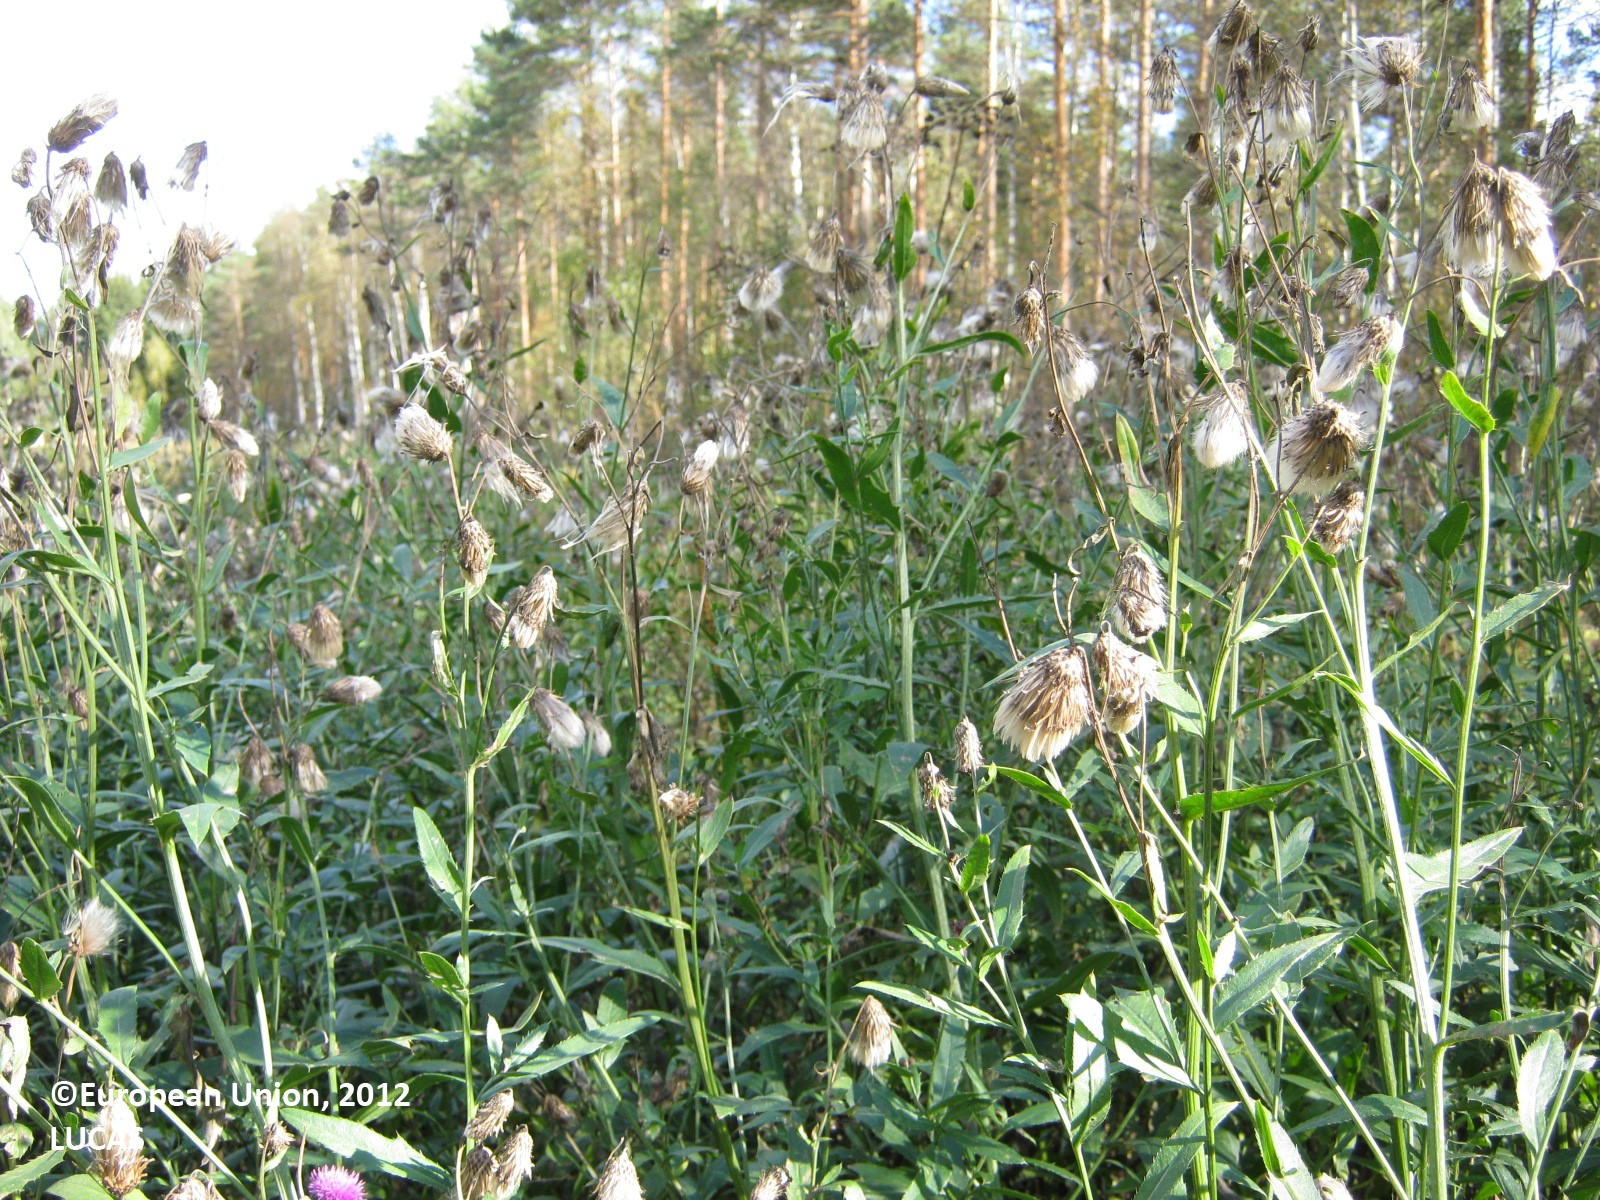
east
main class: Shrubland
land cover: Shrubland with sparse tree cover
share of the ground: > 75 %
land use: Semi-natural and natural areas not in use
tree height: < 5 m
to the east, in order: Shrubland with sparse tree cover; Ditches and canals; Spruce dominated mixed woodland; Other mixed woodland; Ditches and canals; Other coniferous woodland; Broadleaved woodland; Ditches and canals; Paved roads, cycling and walking lanes
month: September
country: FI
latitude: 60.8932
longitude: 27.7544
